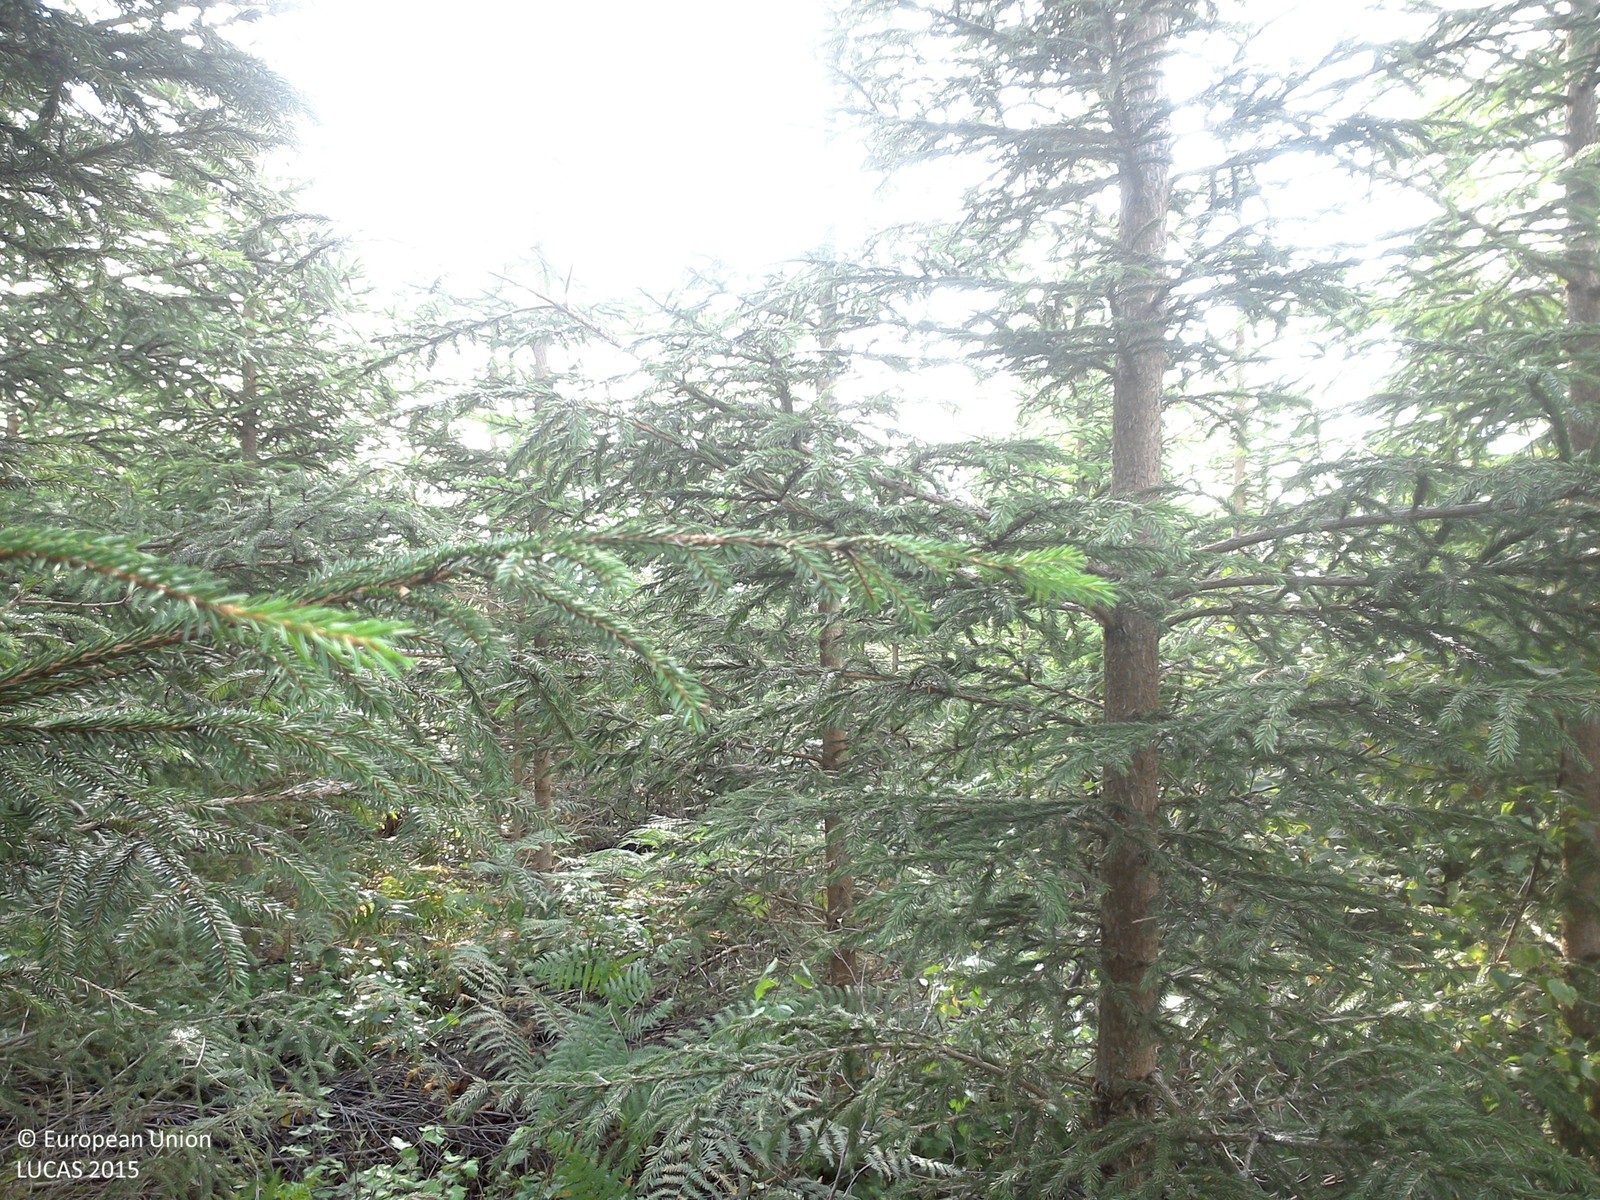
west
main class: Woodland
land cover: Spruce dominated coniferous woodland
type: boreal forest
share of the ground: 50 - 75 %
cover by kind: coniferous forest trees 75 %, herbaceous plants 20 %, lichens and mosses 5 %
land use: Forestry
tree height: < 5 m
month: August
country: SE
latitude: 57.7908
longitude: 15.2944
